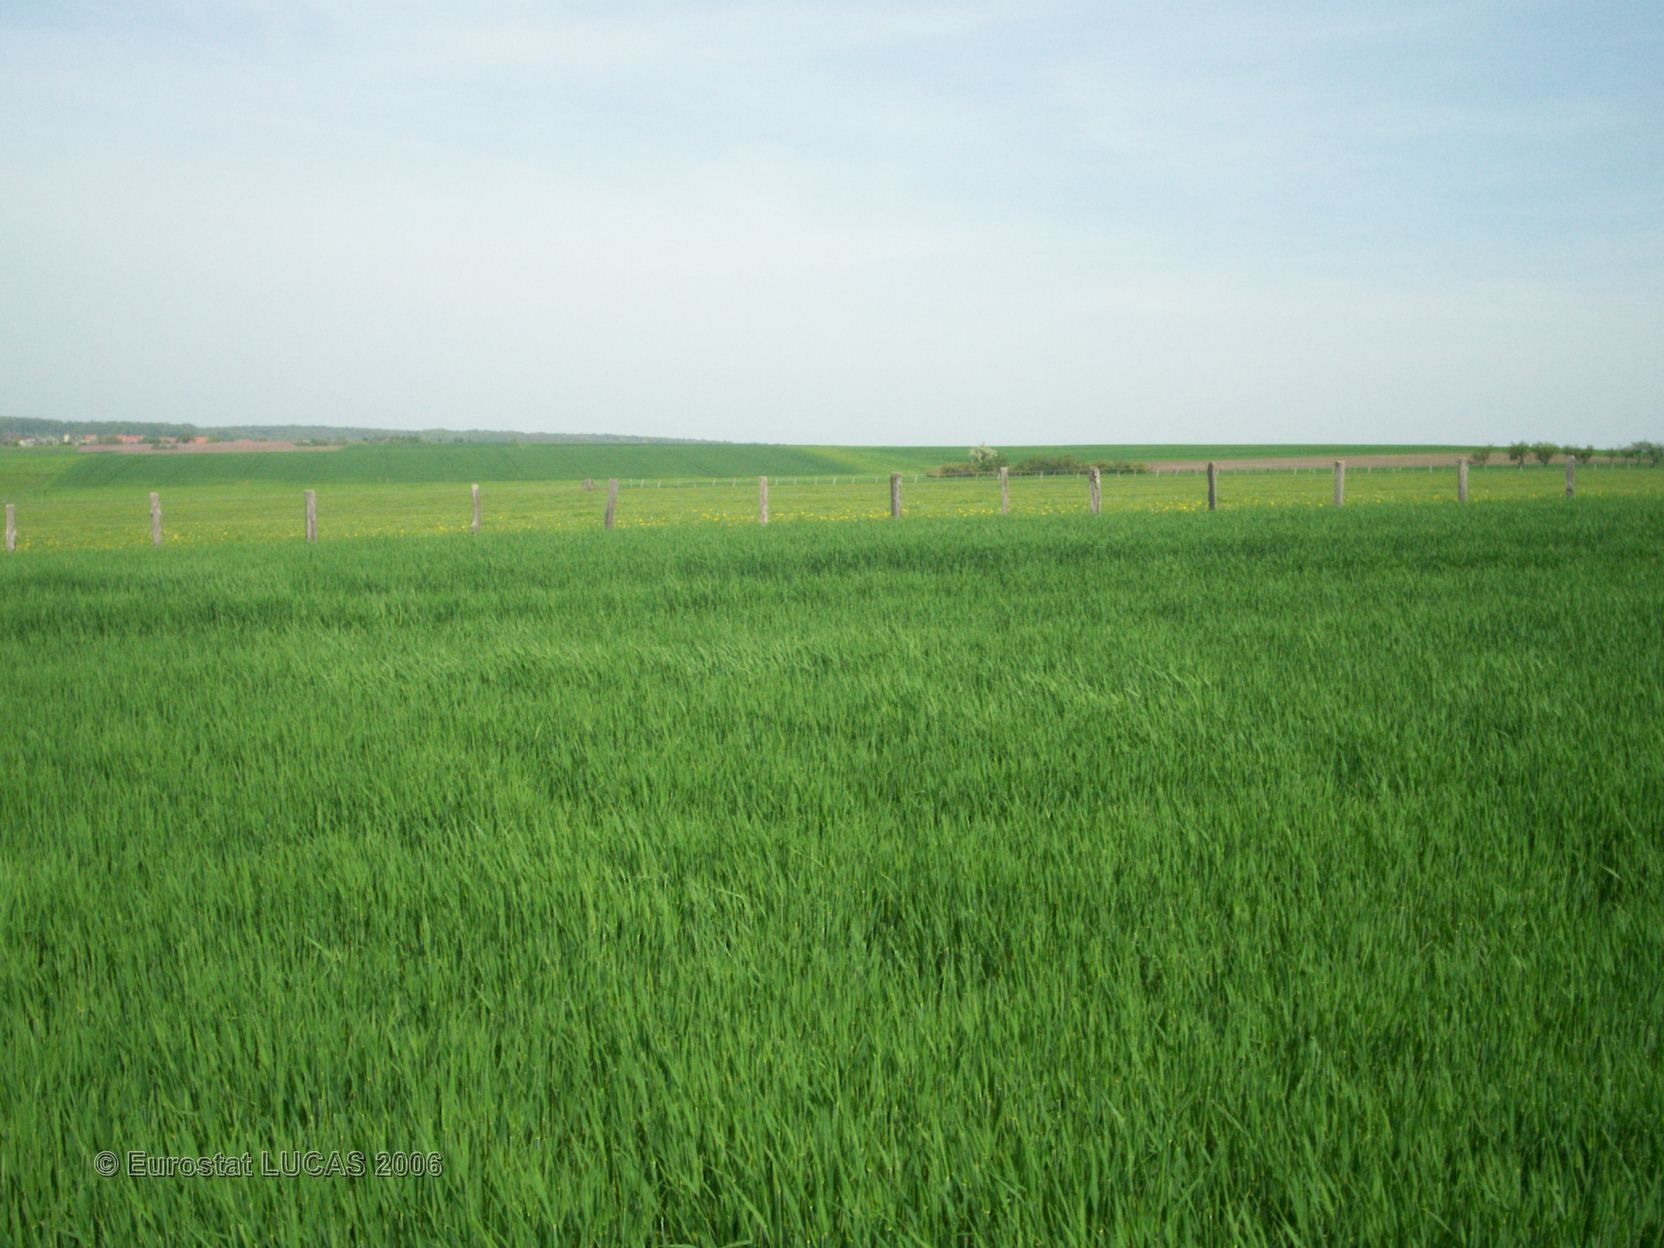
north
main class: Cropland
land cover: Barley
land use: Agriculture (excluding fallow land and kitchen gardens)
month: May
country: FR
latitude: 48.9392
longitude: 7.0106
